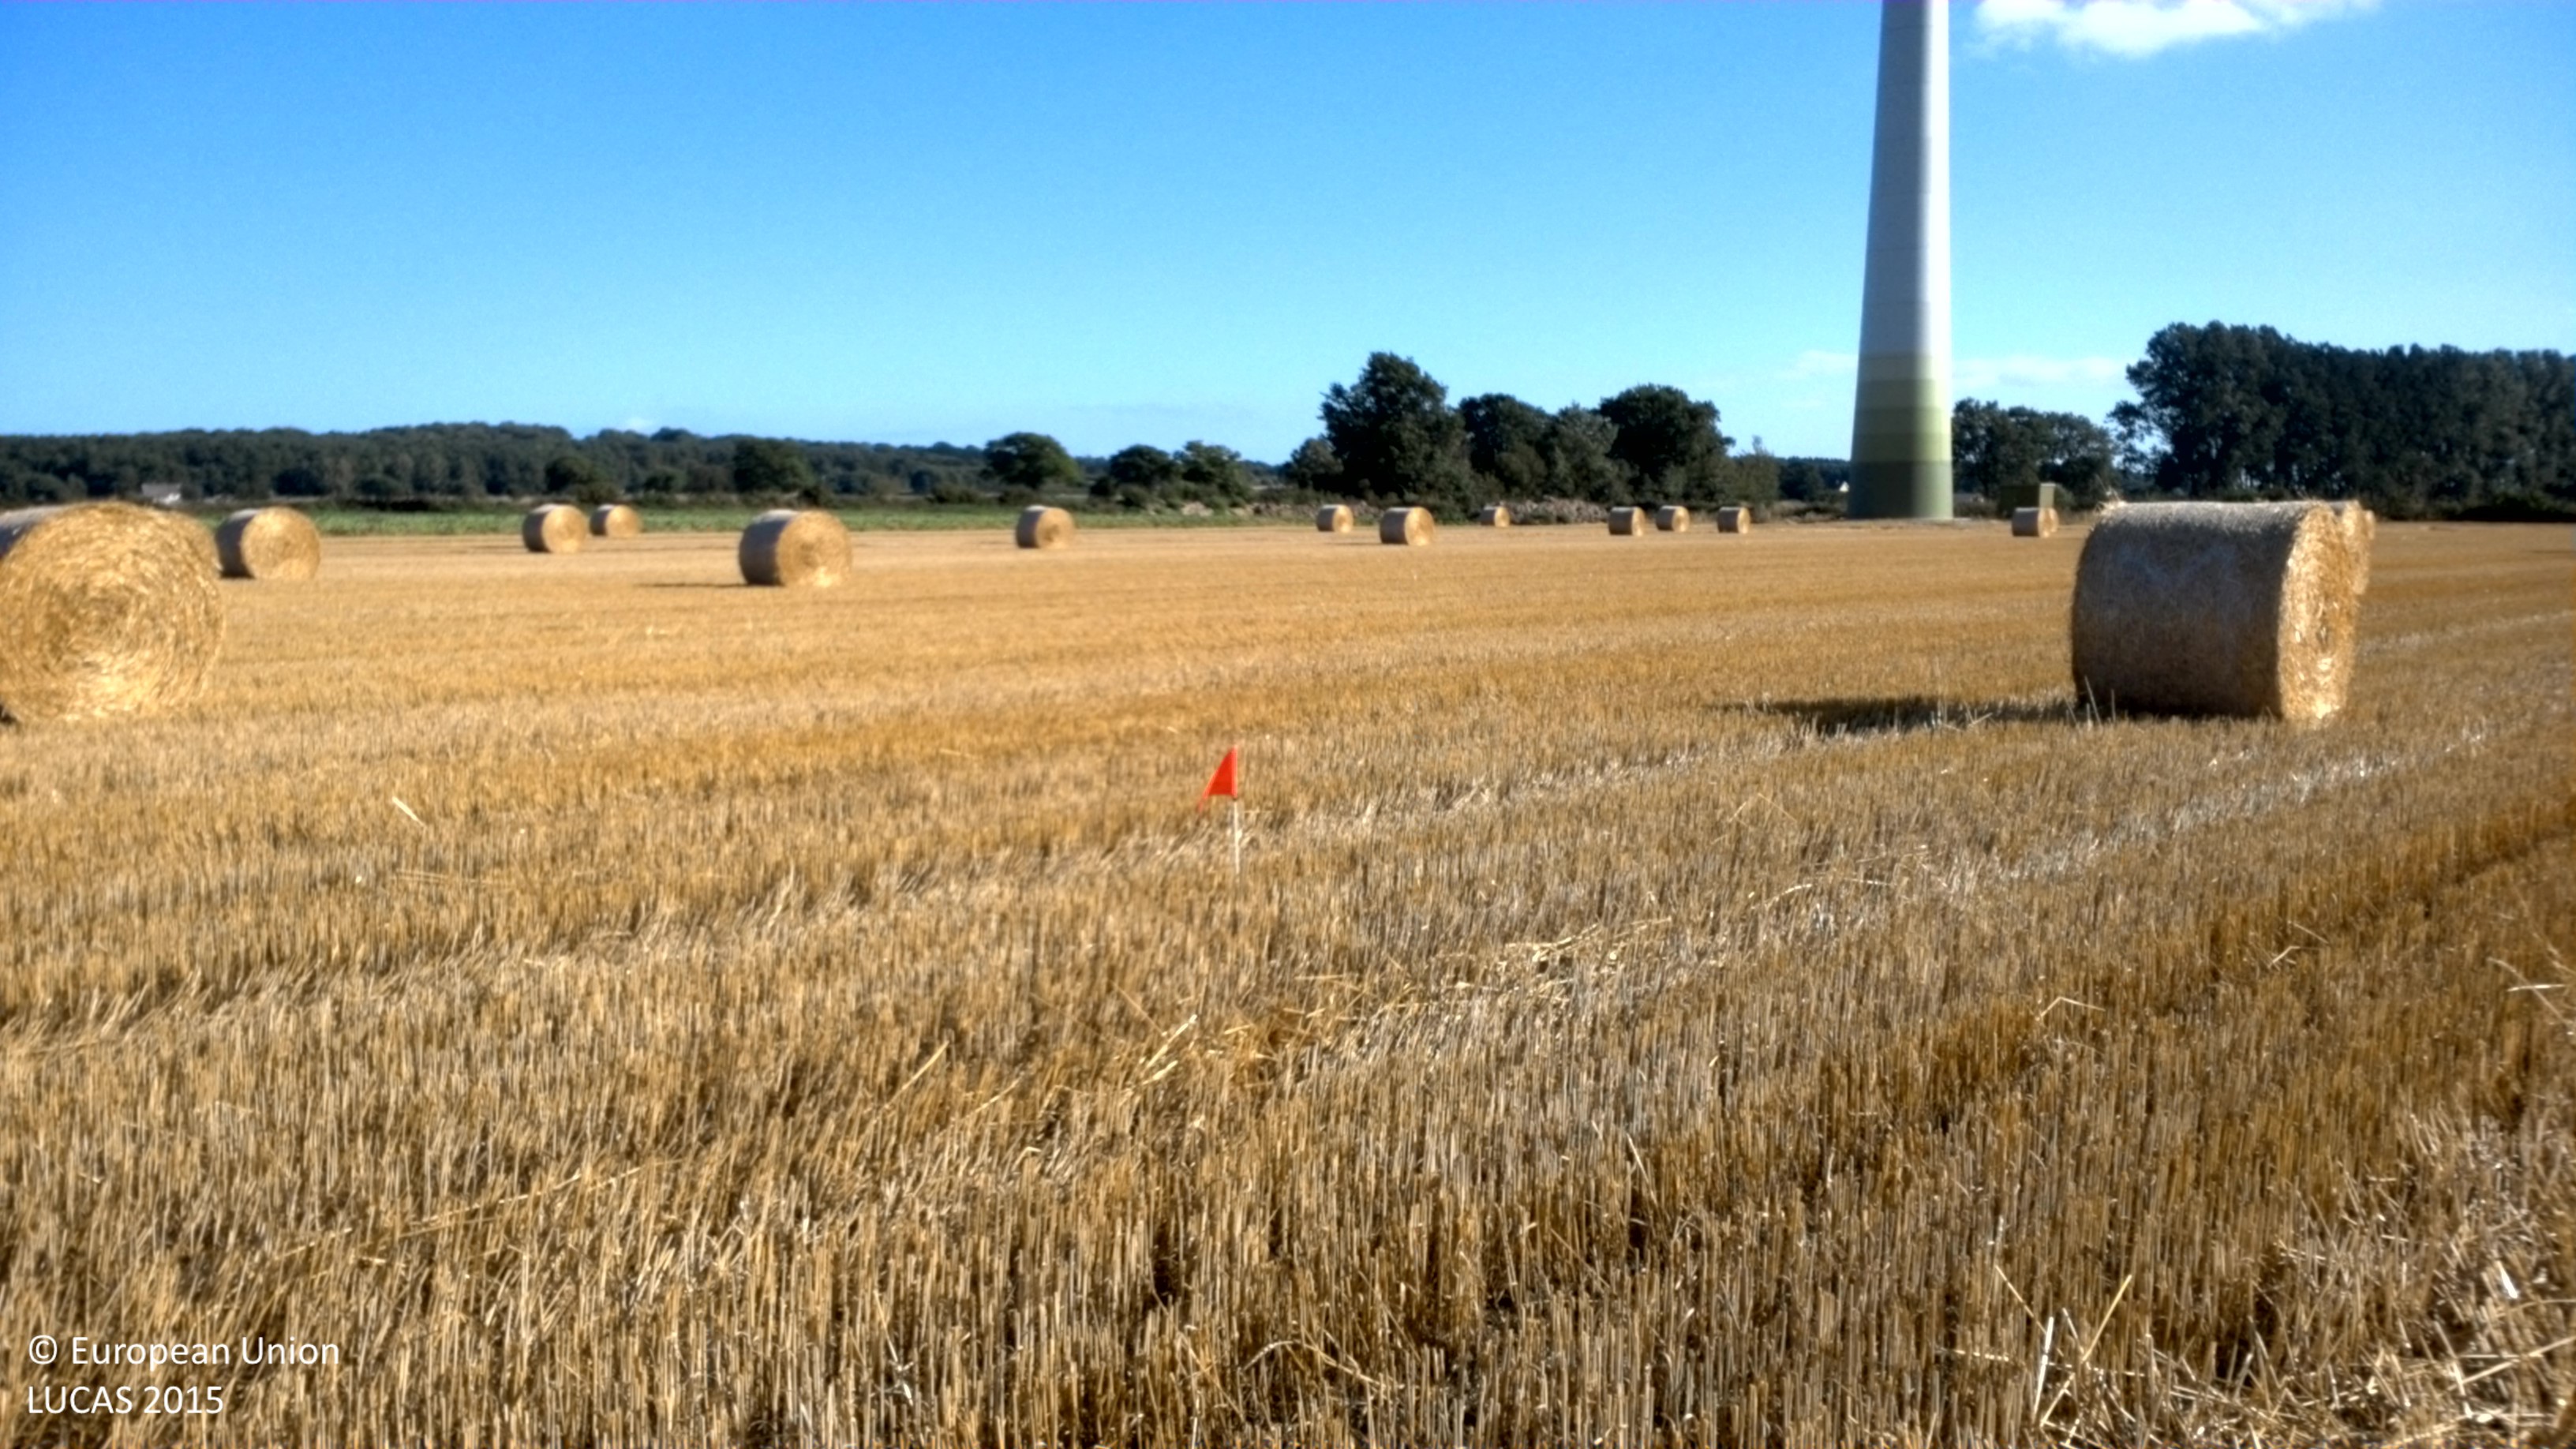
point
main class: Cropland
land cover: Common wheat
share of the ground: > 75 %
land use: Agriculture (excluding fallow land and kitchen gardens)
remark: Harvested field
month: September
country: SE
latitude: 56.0309
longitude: 14.6683
